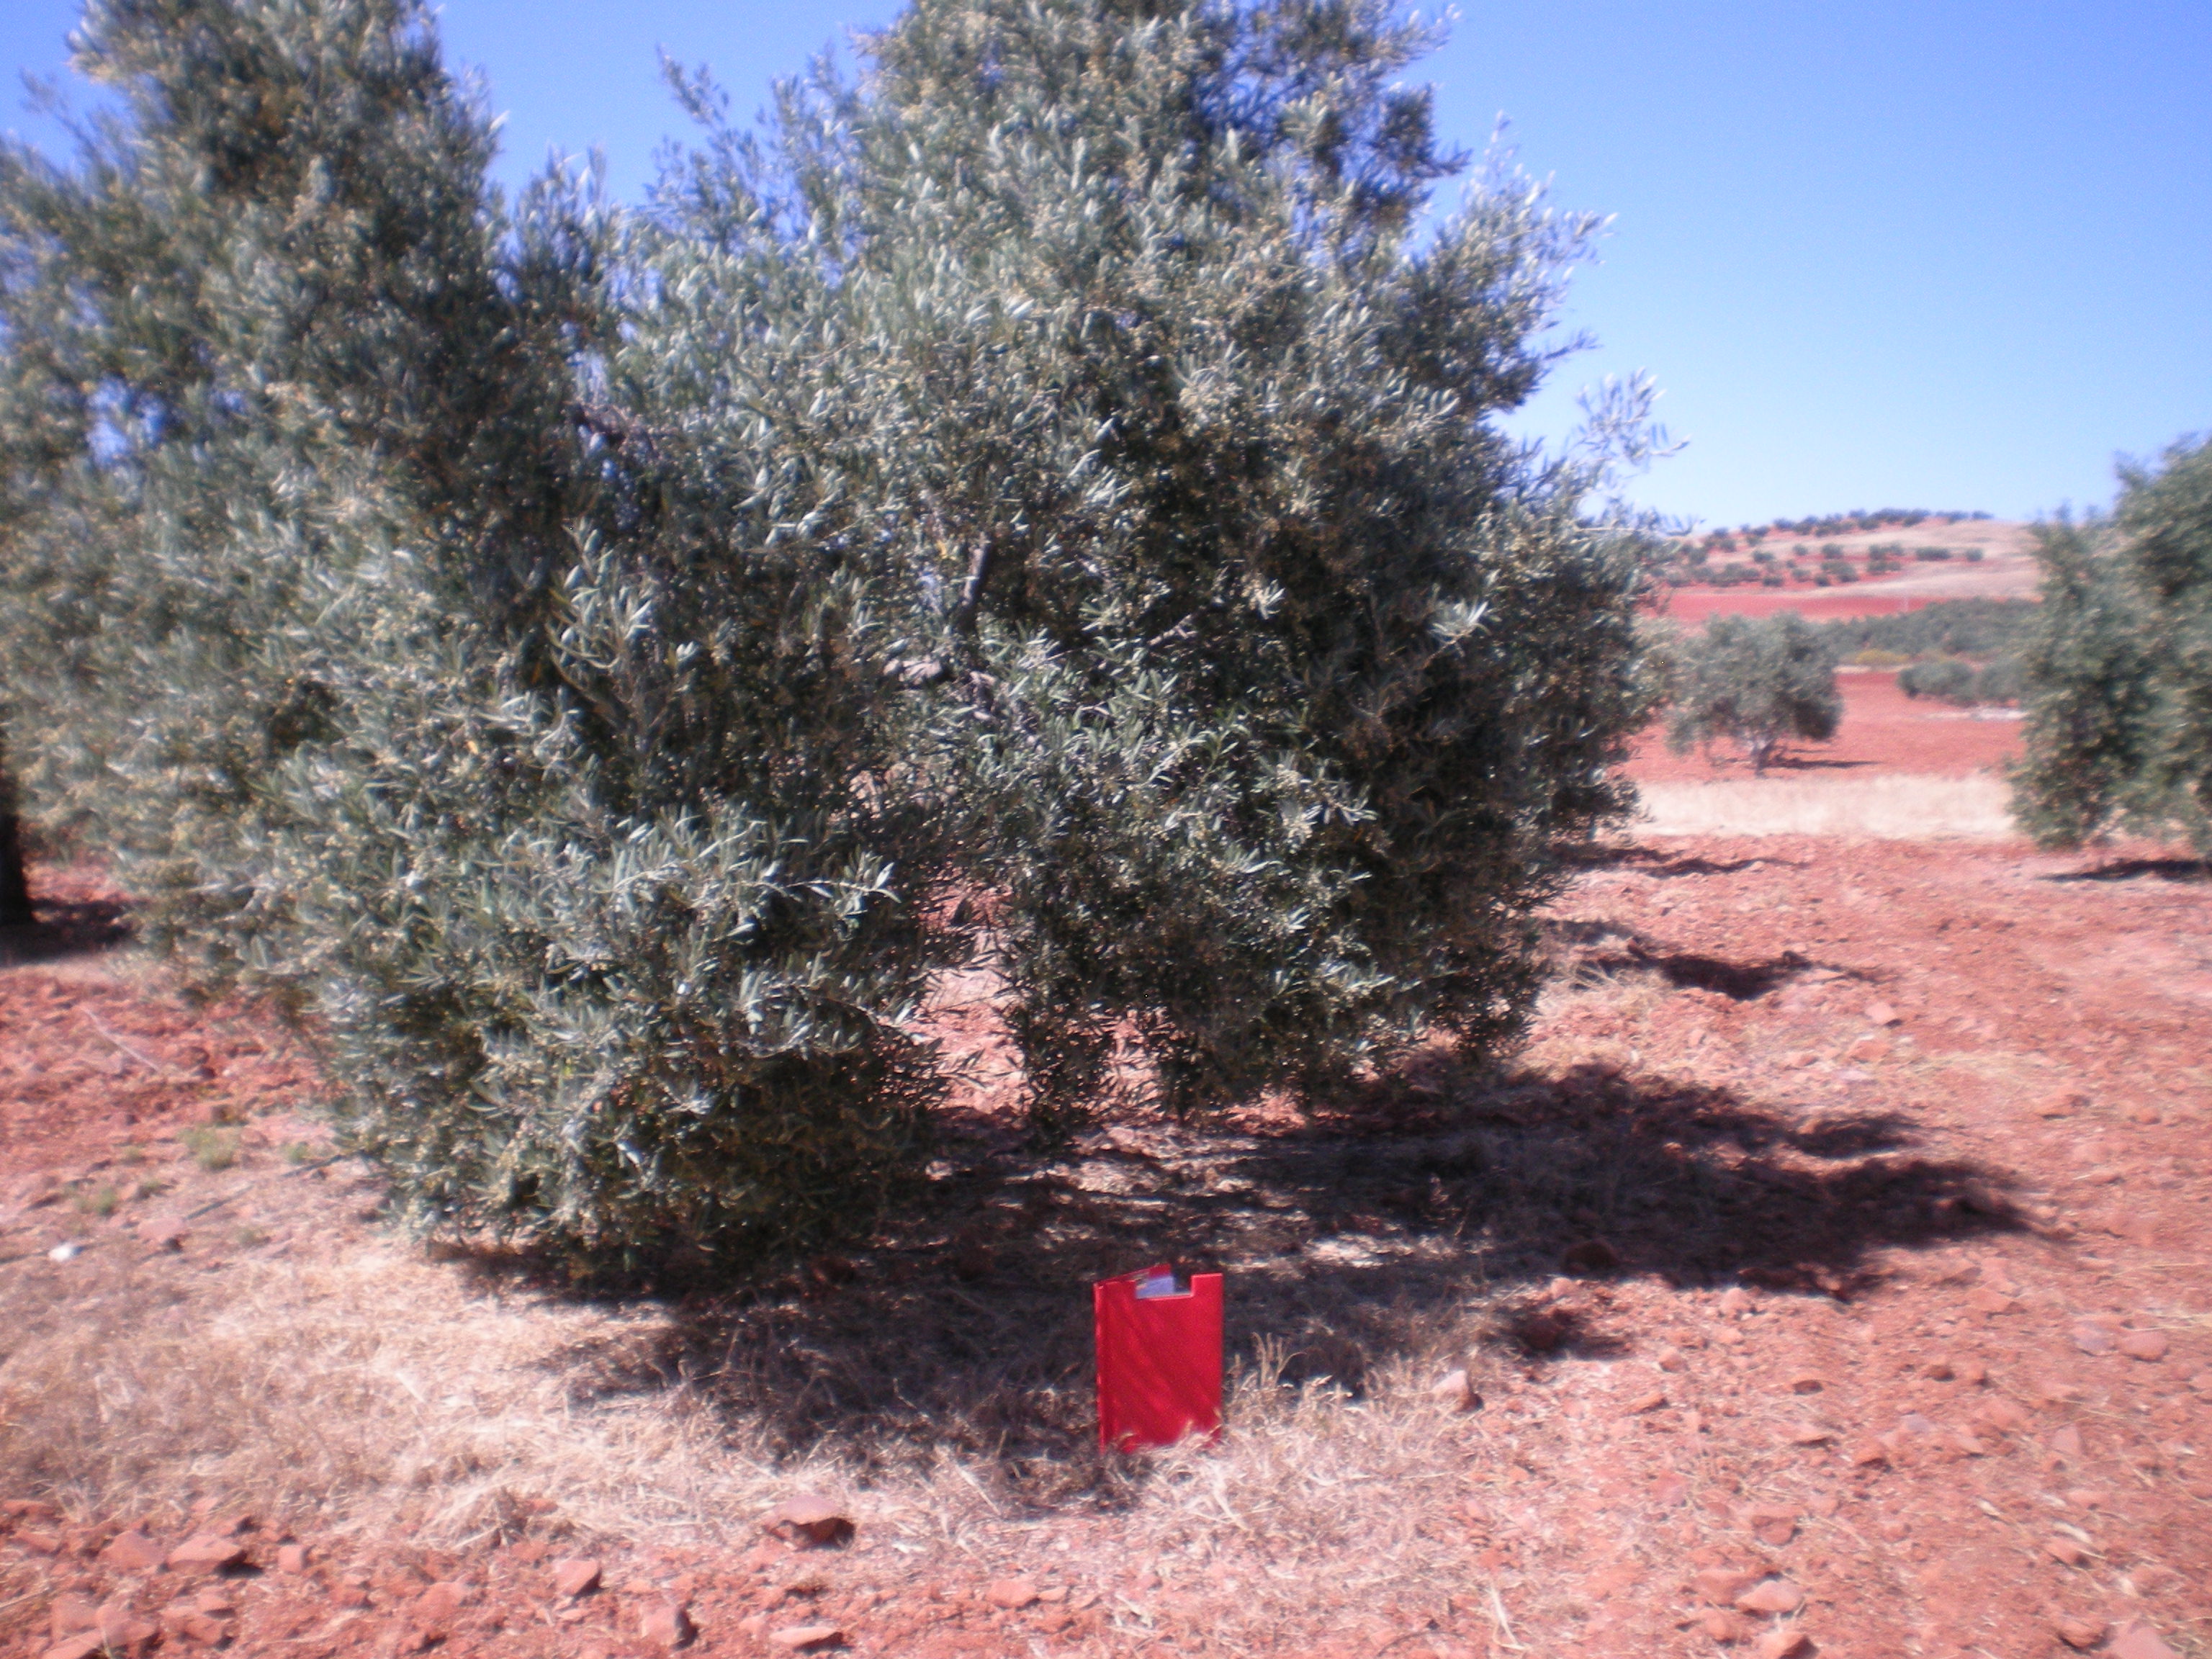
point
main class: Cropland
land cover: Olive groves
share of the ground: 10 - 25 %
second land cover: Other bare soil
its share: > 75 %
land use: Agriculture (excluding fallow land and kitchen gardens)
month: May
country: ES
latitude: 38.7255
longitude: -3.3645
